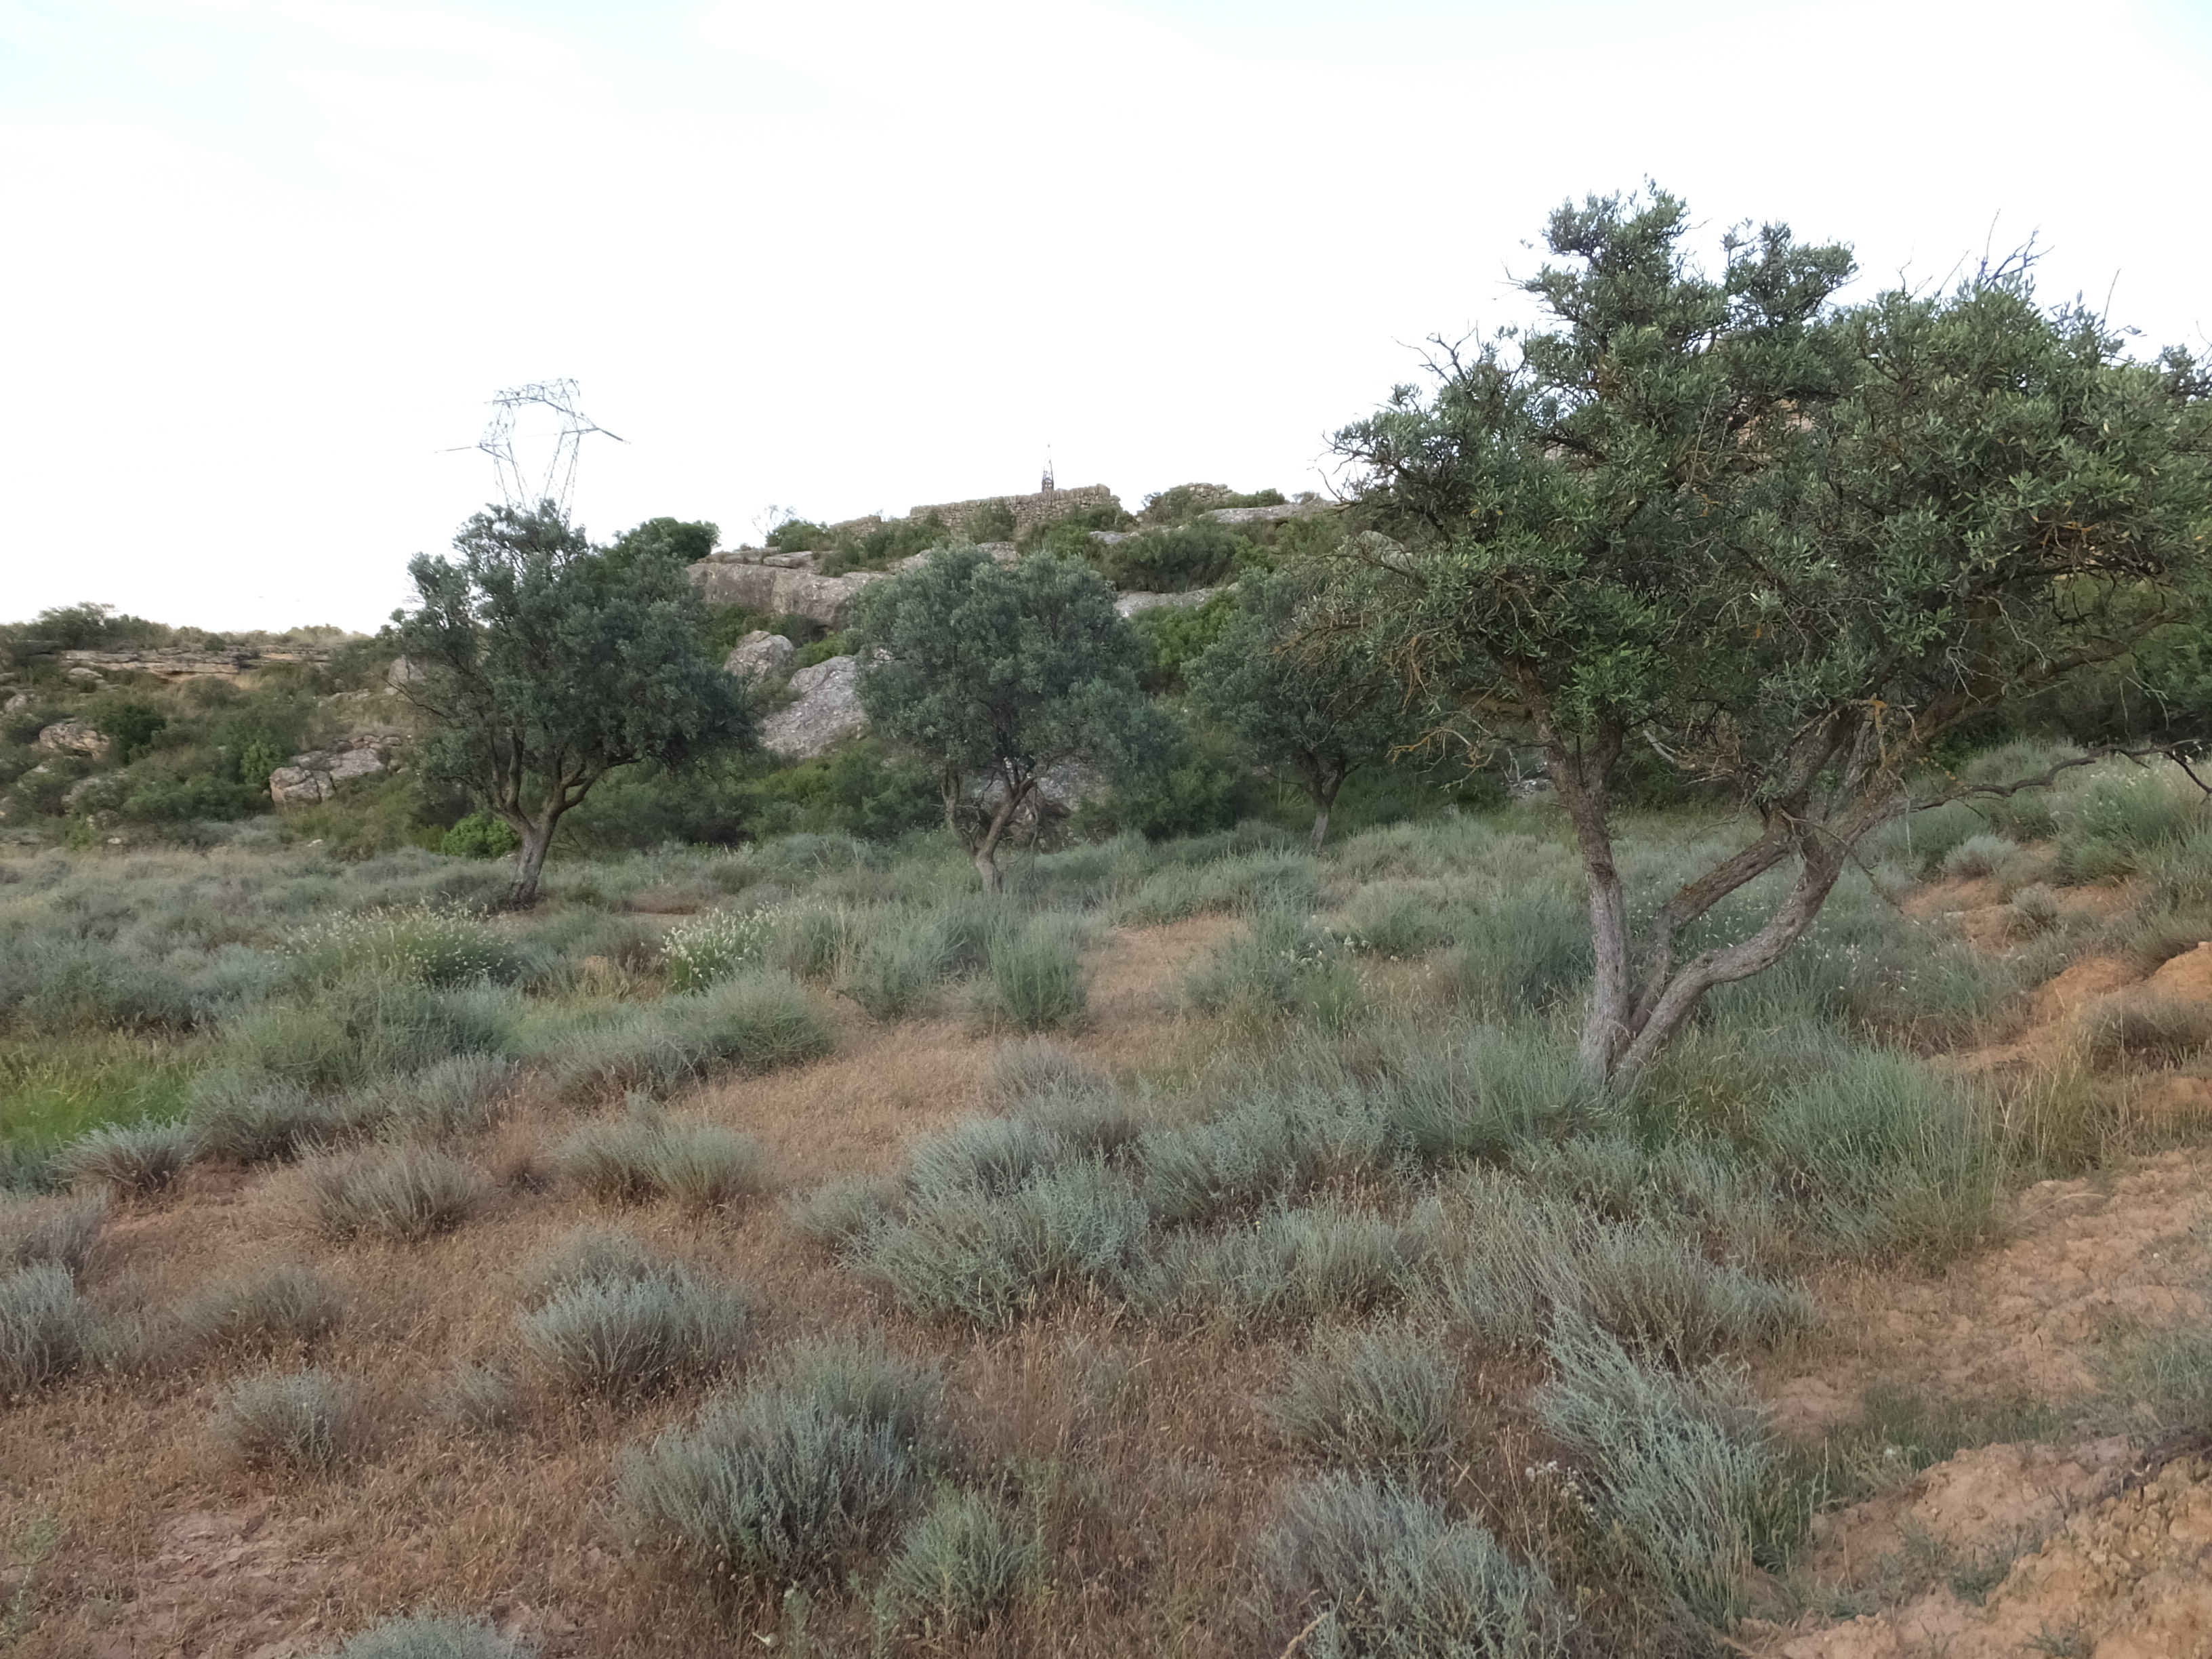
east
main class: Cropland
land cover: Nuts trees
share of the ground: 50 - 75 %
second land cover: Shrubland without tree cover
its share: 25 - 50 %
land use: Abandoned areas
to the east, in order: Nuts trees; Shrubland without tree cover; Olive groves; Shruby margins; Rocks and stones; Shrubland without tree cover; Olive groves; Electric lines; Olive groves
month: June
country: ES
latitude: 41.2680
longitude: -0.3400
